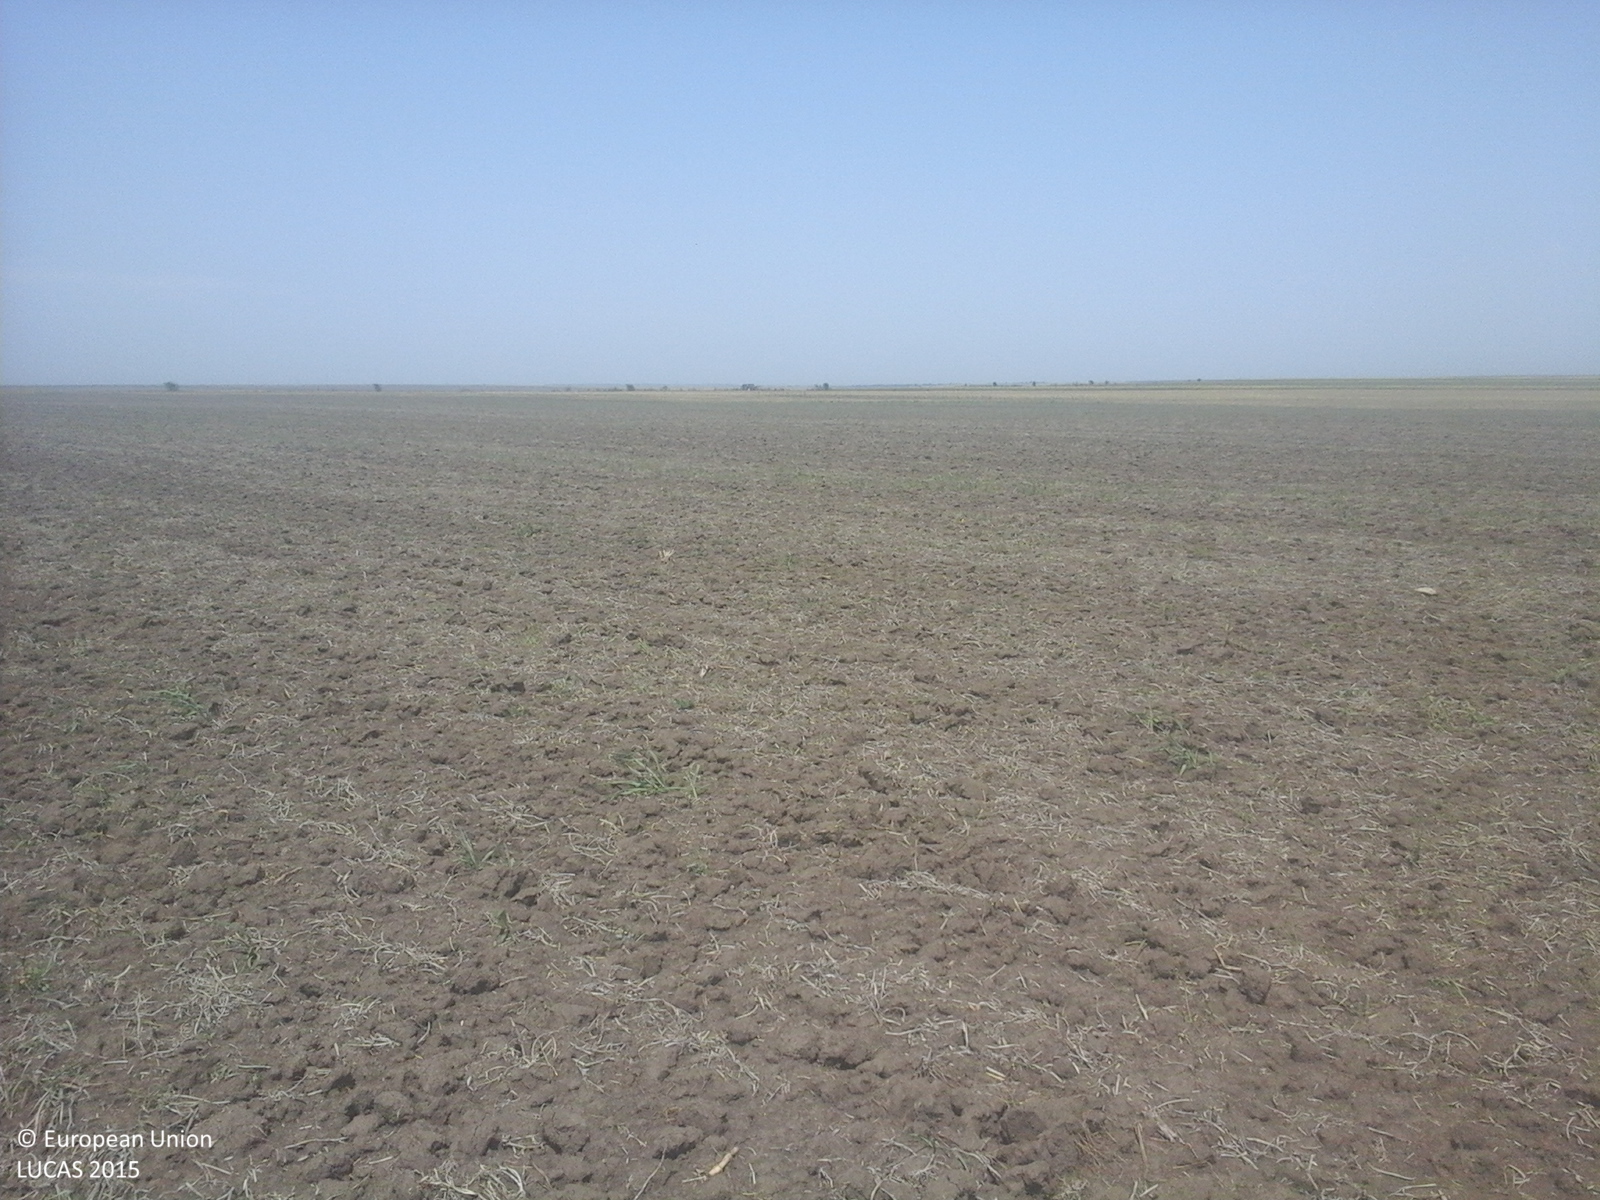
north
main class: Cropland
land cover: Soya
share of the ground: < 10 %
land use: Agriculture (excluding fallow land and kitchen gardens)
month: August
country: RO
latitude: 43.8882
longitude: 28.2956
